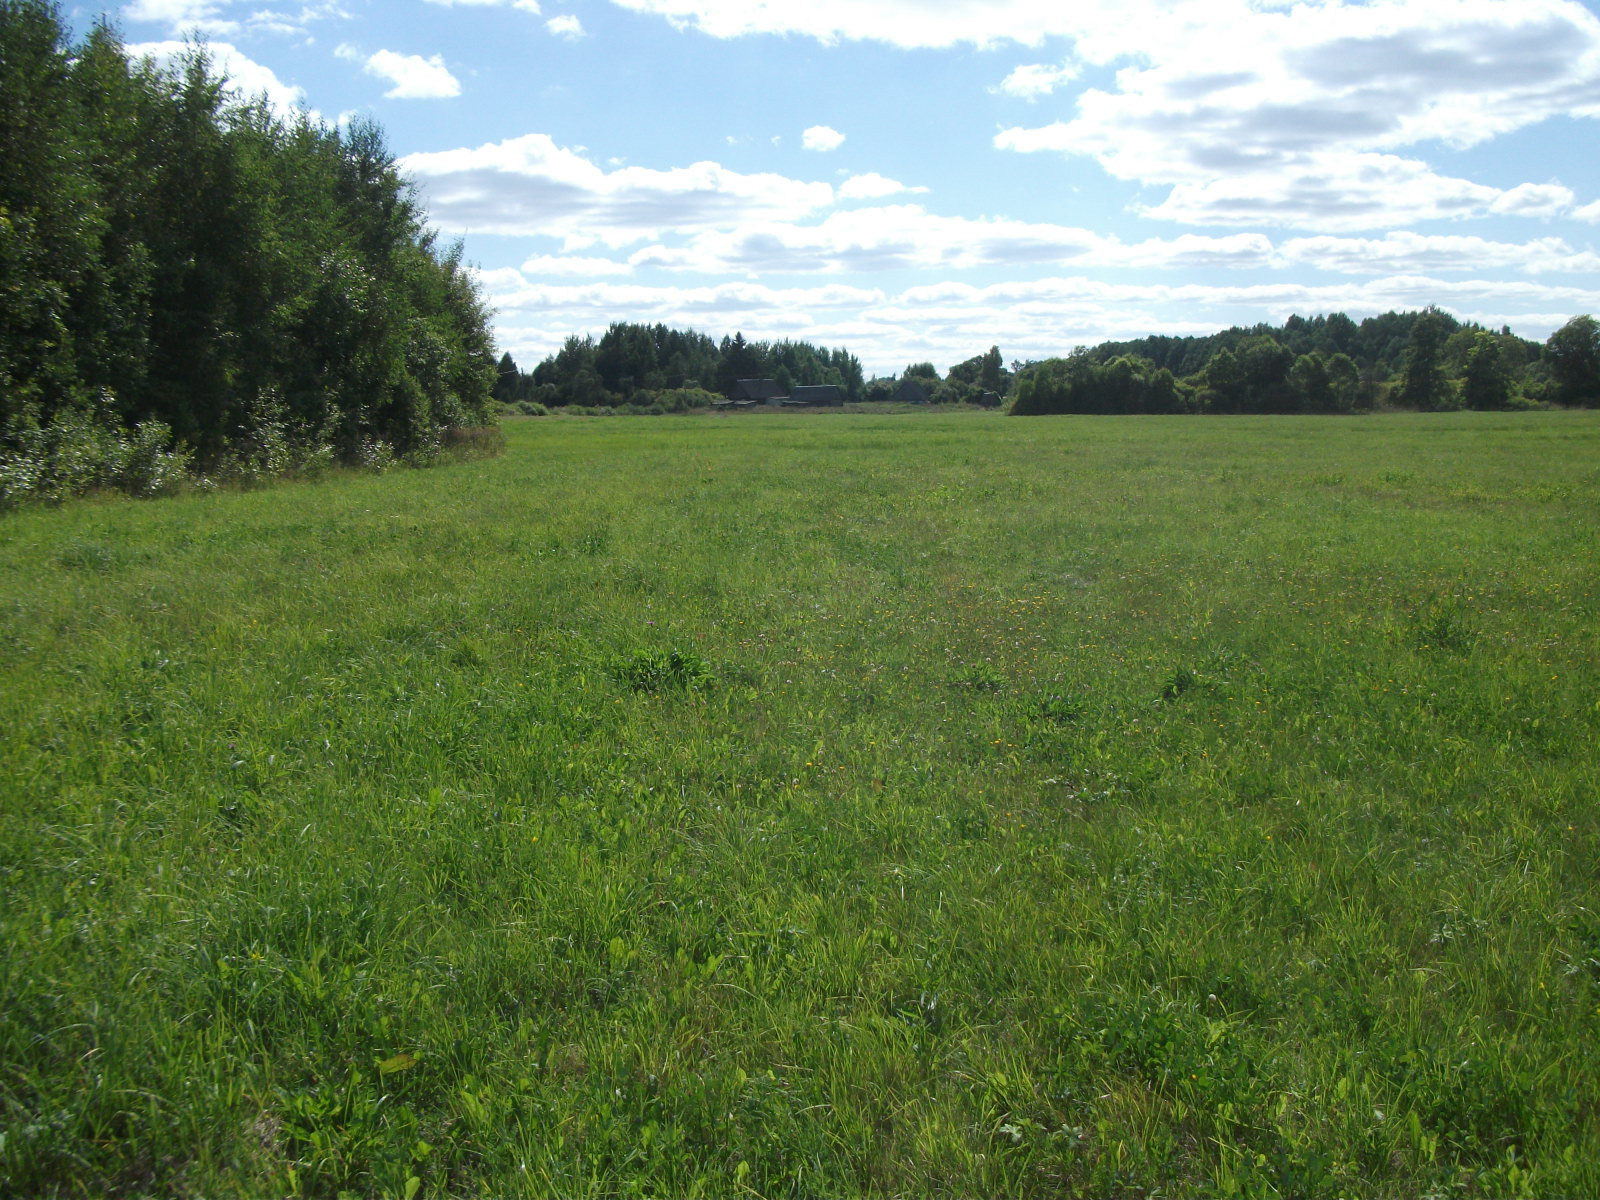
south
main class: Grassland
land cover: Grassland without tree/shrub cover
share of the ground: > 75 %
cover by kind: herbaceous plants 100 %
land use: Agriculture (excluding fallow land and kitchen gardens)
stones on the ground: < 10 %
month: August
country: LV
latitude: 56.4310
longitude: 26.3766
